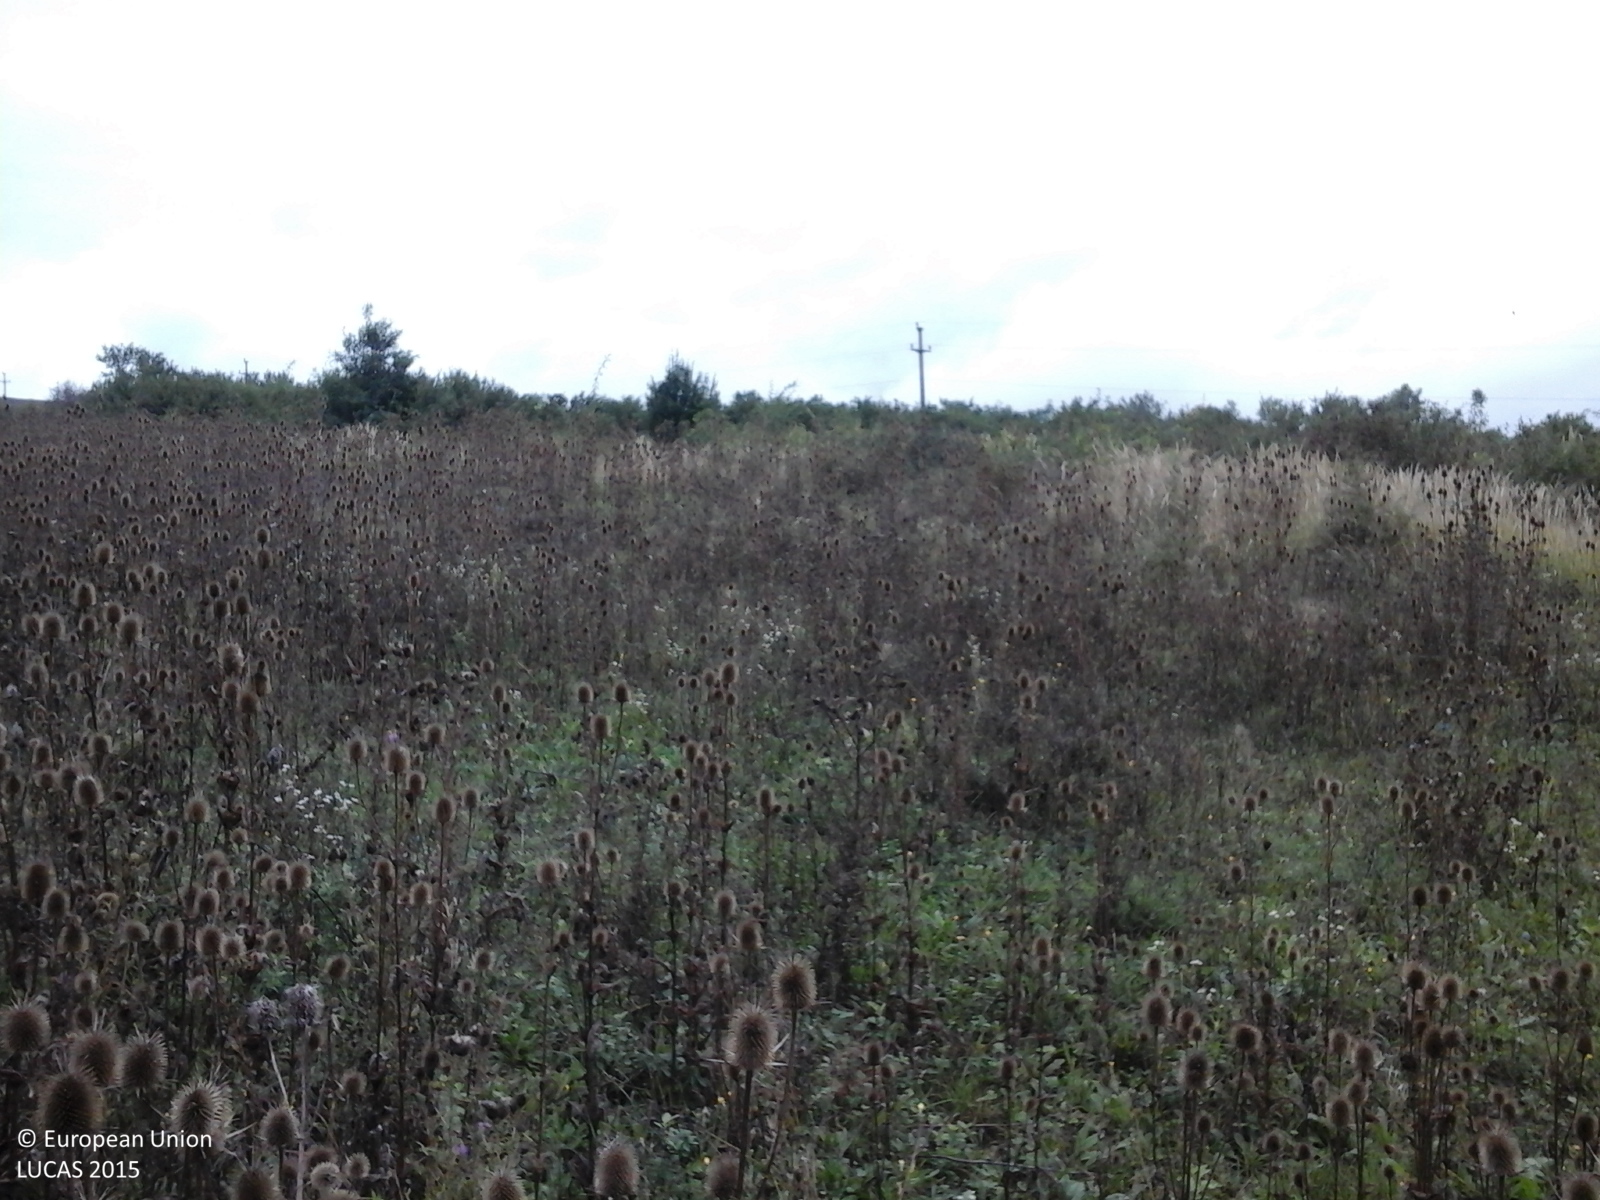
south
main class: Grassland
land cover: Spontaneously vegetated surfaces
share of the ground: > 75 %
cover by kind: herbaceous plants 100 %
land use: Agriculture (excluding fallow land and kitchen gardens)
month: September
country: RO
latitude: 45.8686
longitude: 23.6830
